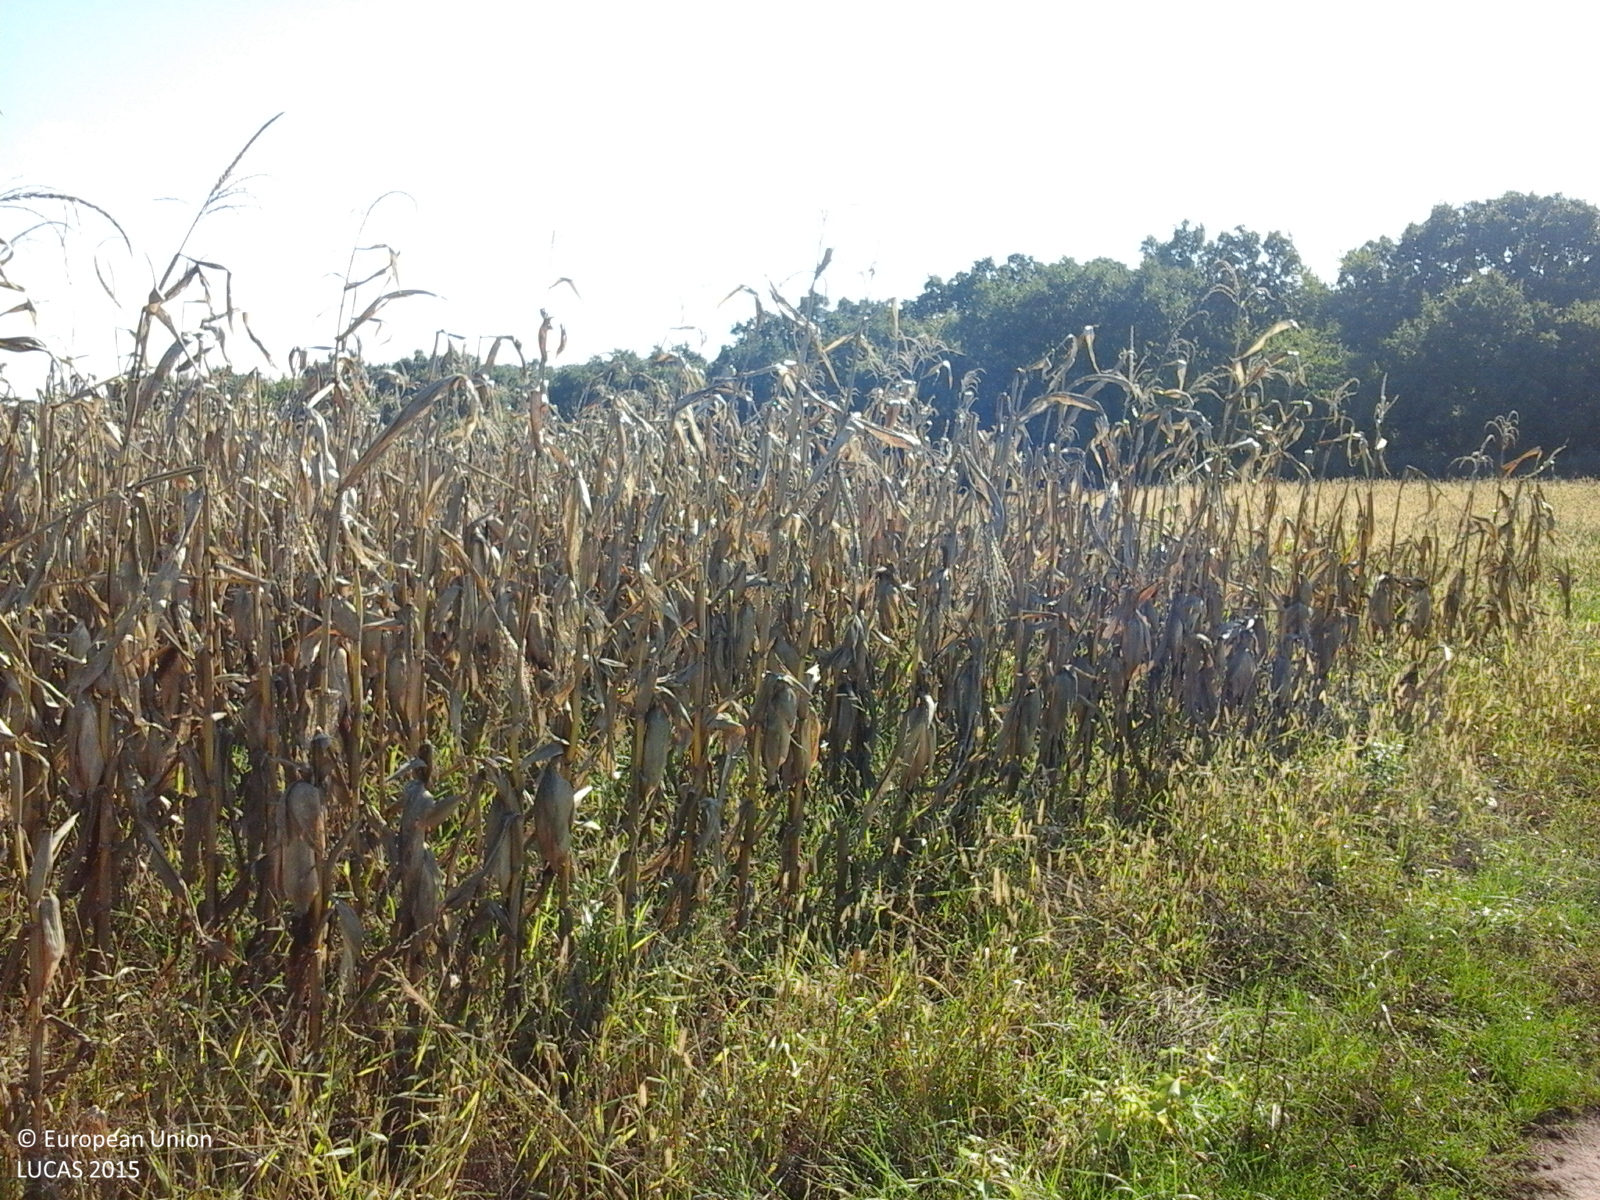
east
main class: Cropland
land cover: Maize
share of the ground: > 75 %
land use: Agriculture (excluding fallow land and kitchen gardens)
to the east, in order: Tracks; Grass margins; Maize; Grassland without tree/shrub cover; Maize; Broadleaved woodland
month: October
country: RO
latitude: 46.0993
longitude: 23.8741
